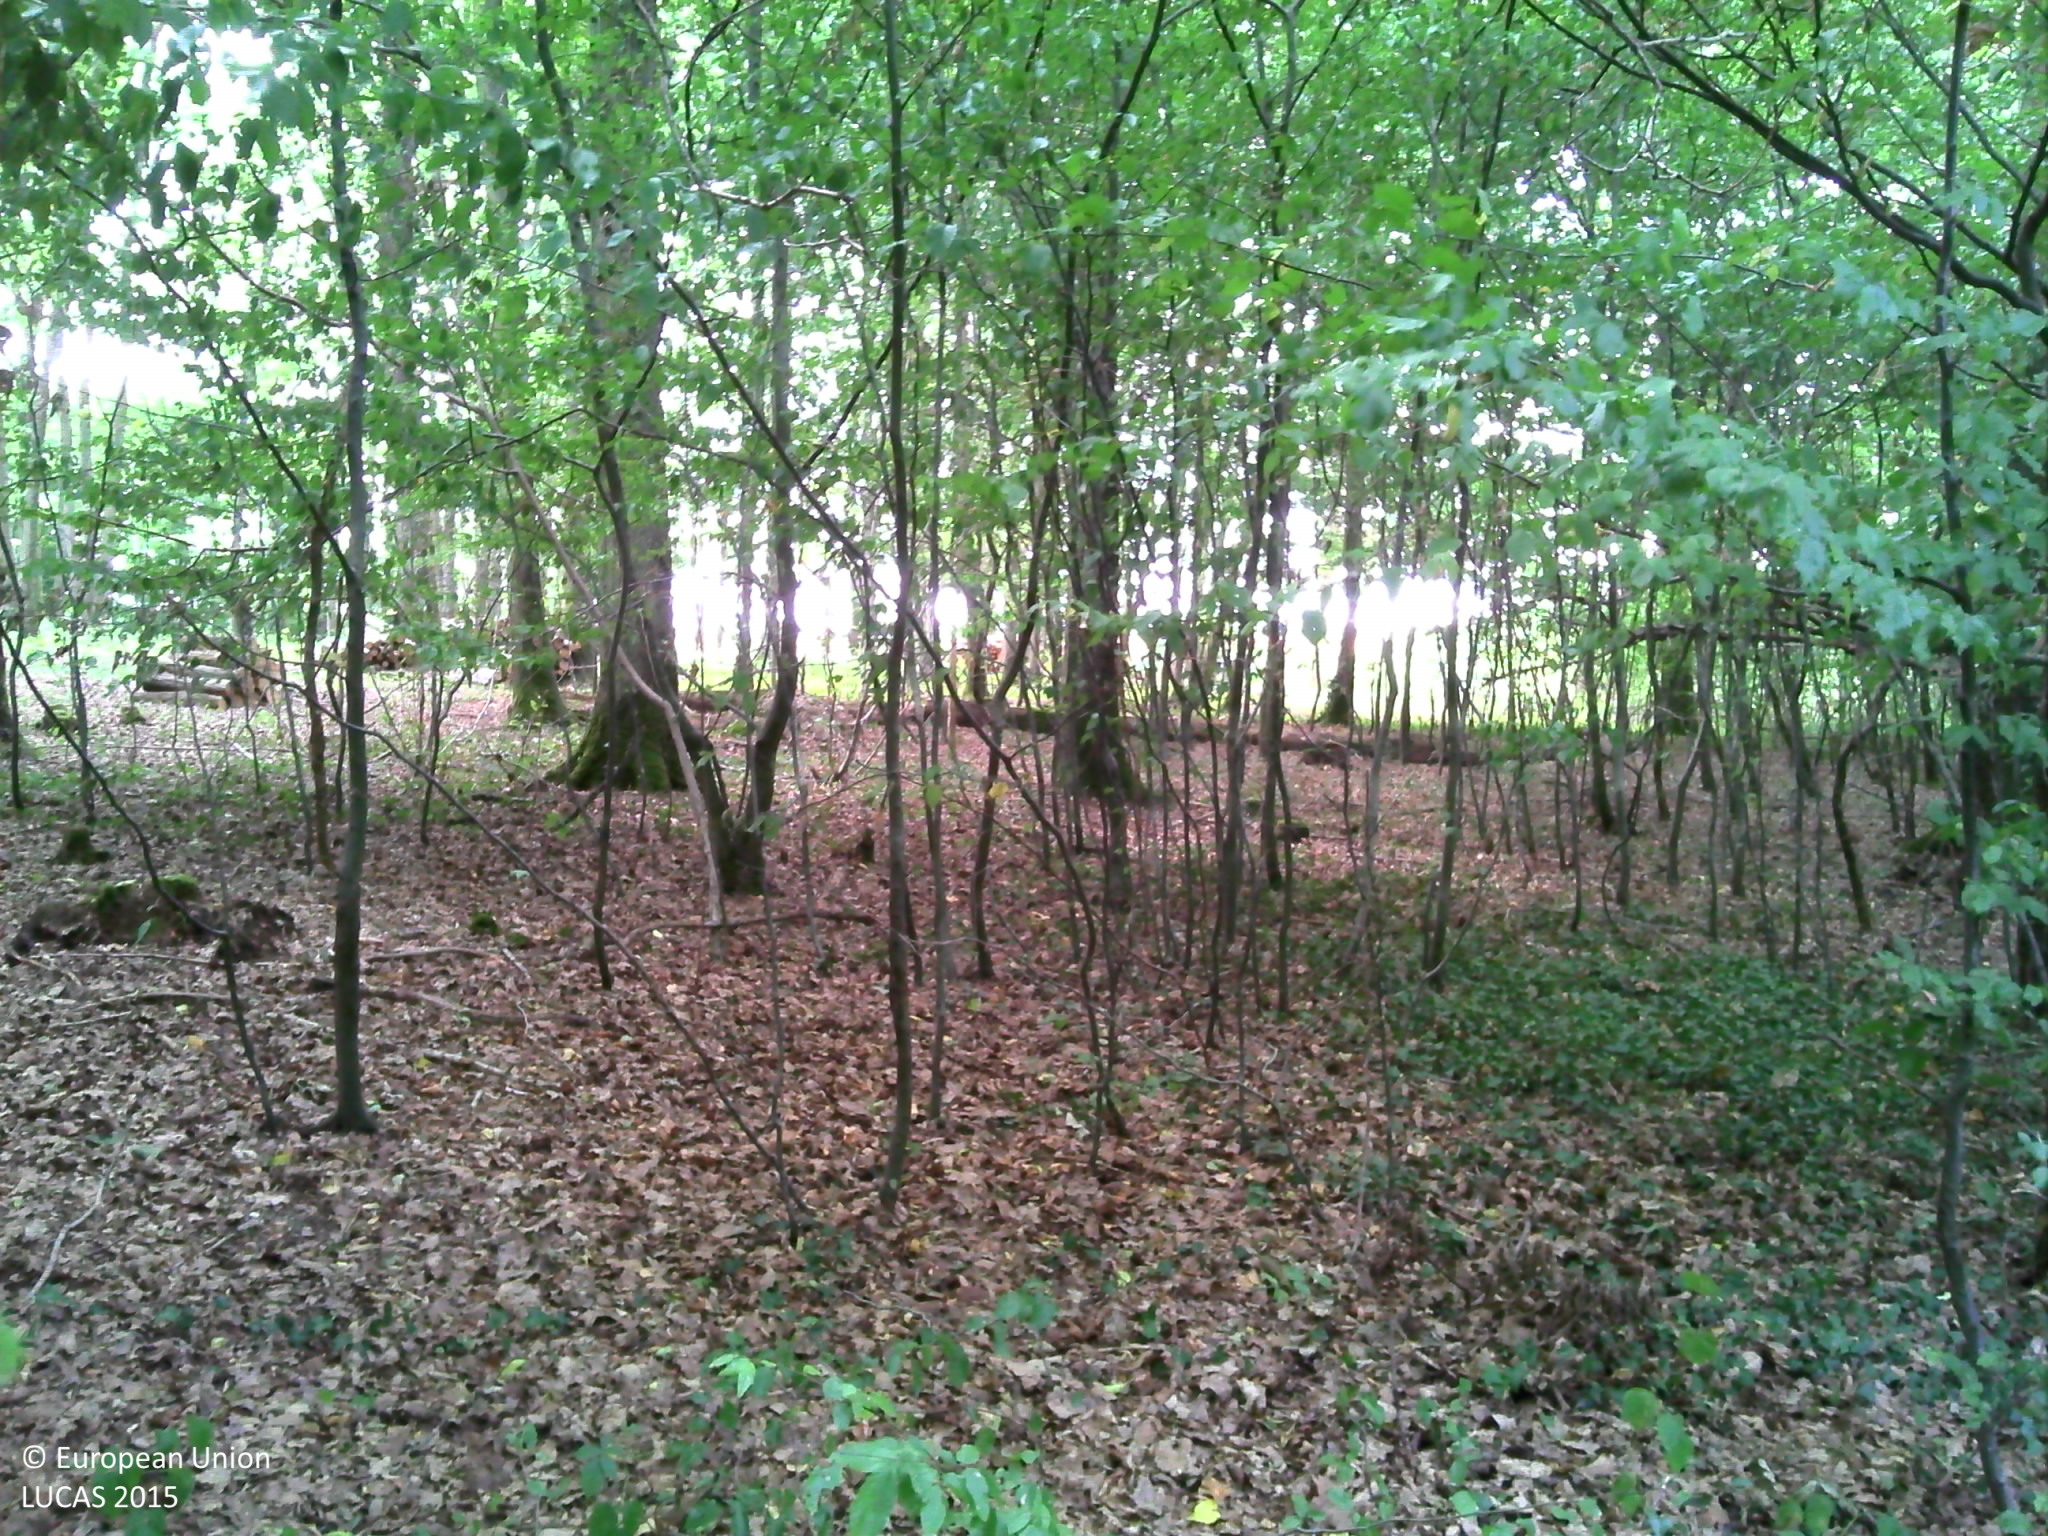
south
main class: Woodland
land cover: Broadleaved woodland
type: mesophytic deciduous forest
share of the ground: > 75 %
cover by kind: broadleaved forest trees 90 %, herbaceous plants 5 %, lichens and mosses 5 %
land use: Forestry
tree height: > 5 m
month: July
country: FR
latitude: 47.9350
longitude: 3.0998
